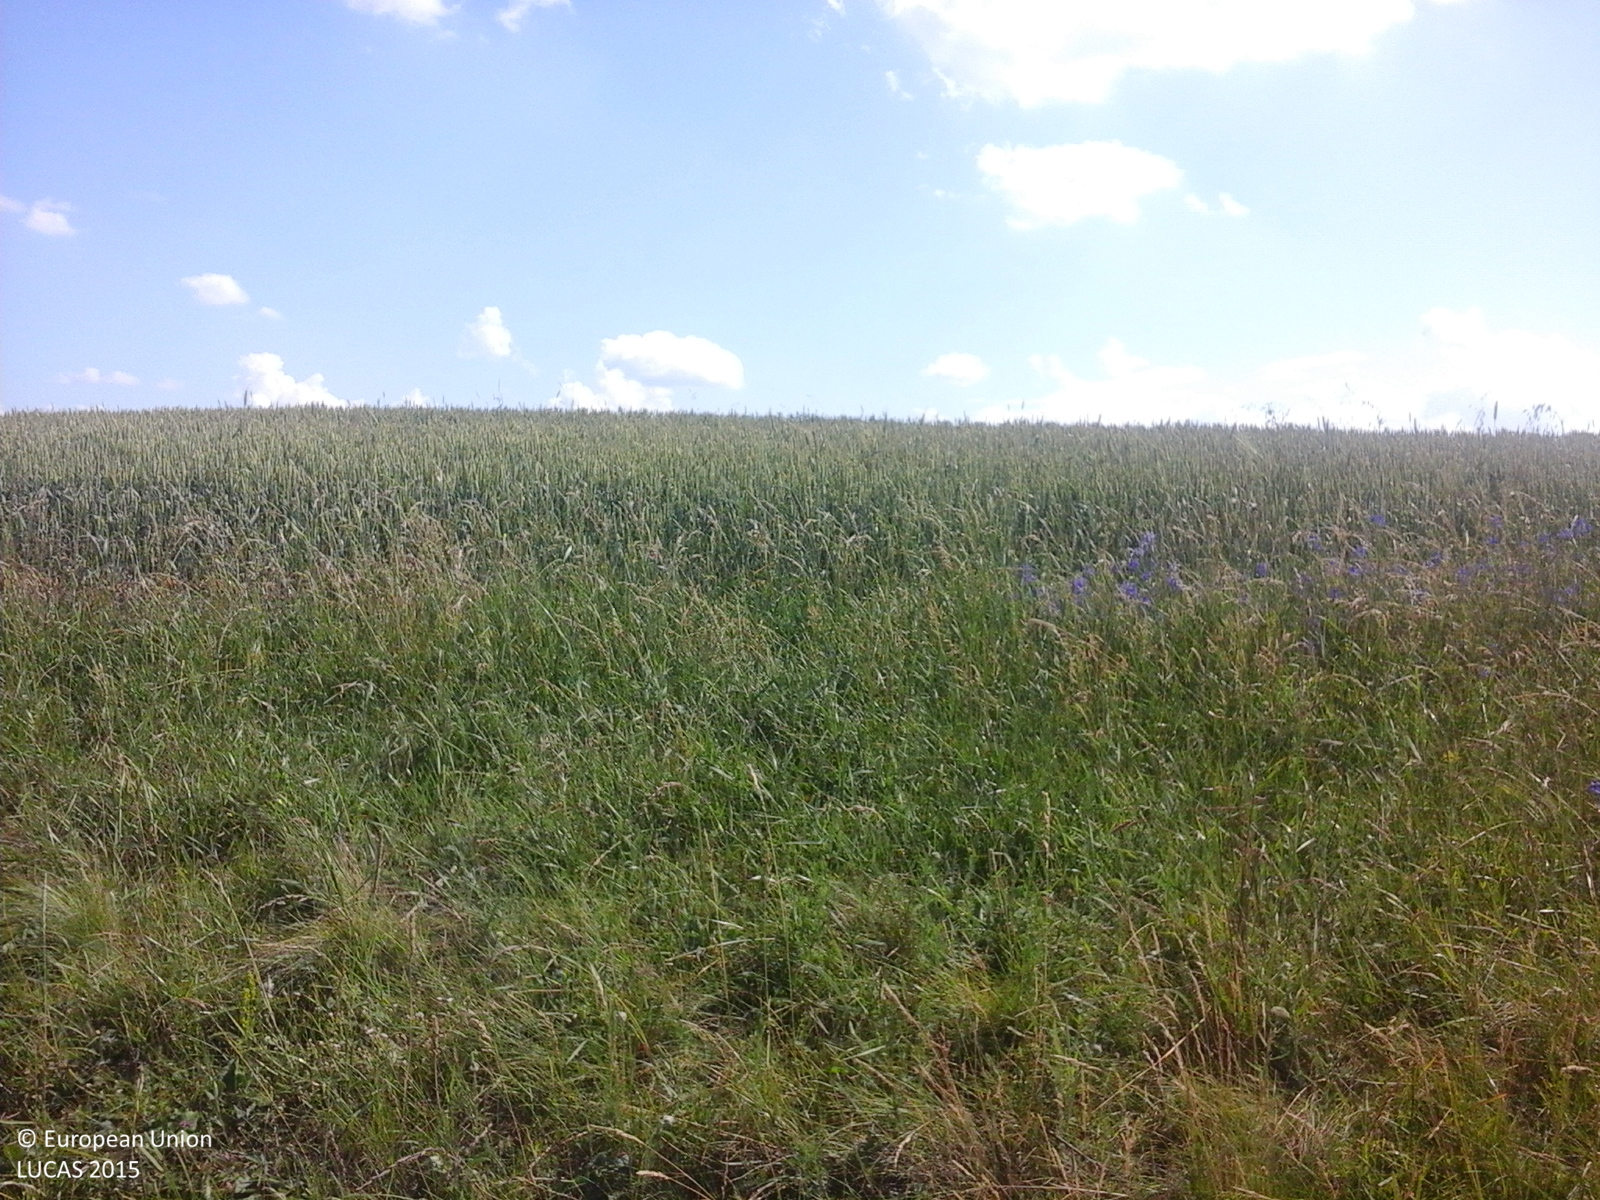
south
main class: Grassland
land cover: Grassland with sparse tree/shrub cover
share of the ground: > 75 %
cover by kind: herbaceous plants 85 %, shrubs 10 %, broadleaved forest trees 5 %
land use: Agriculture (excluding fallow land and kitchen gardens)
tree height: < 5 m
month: June
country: RO
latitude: 48.1719
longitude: 26.6785
